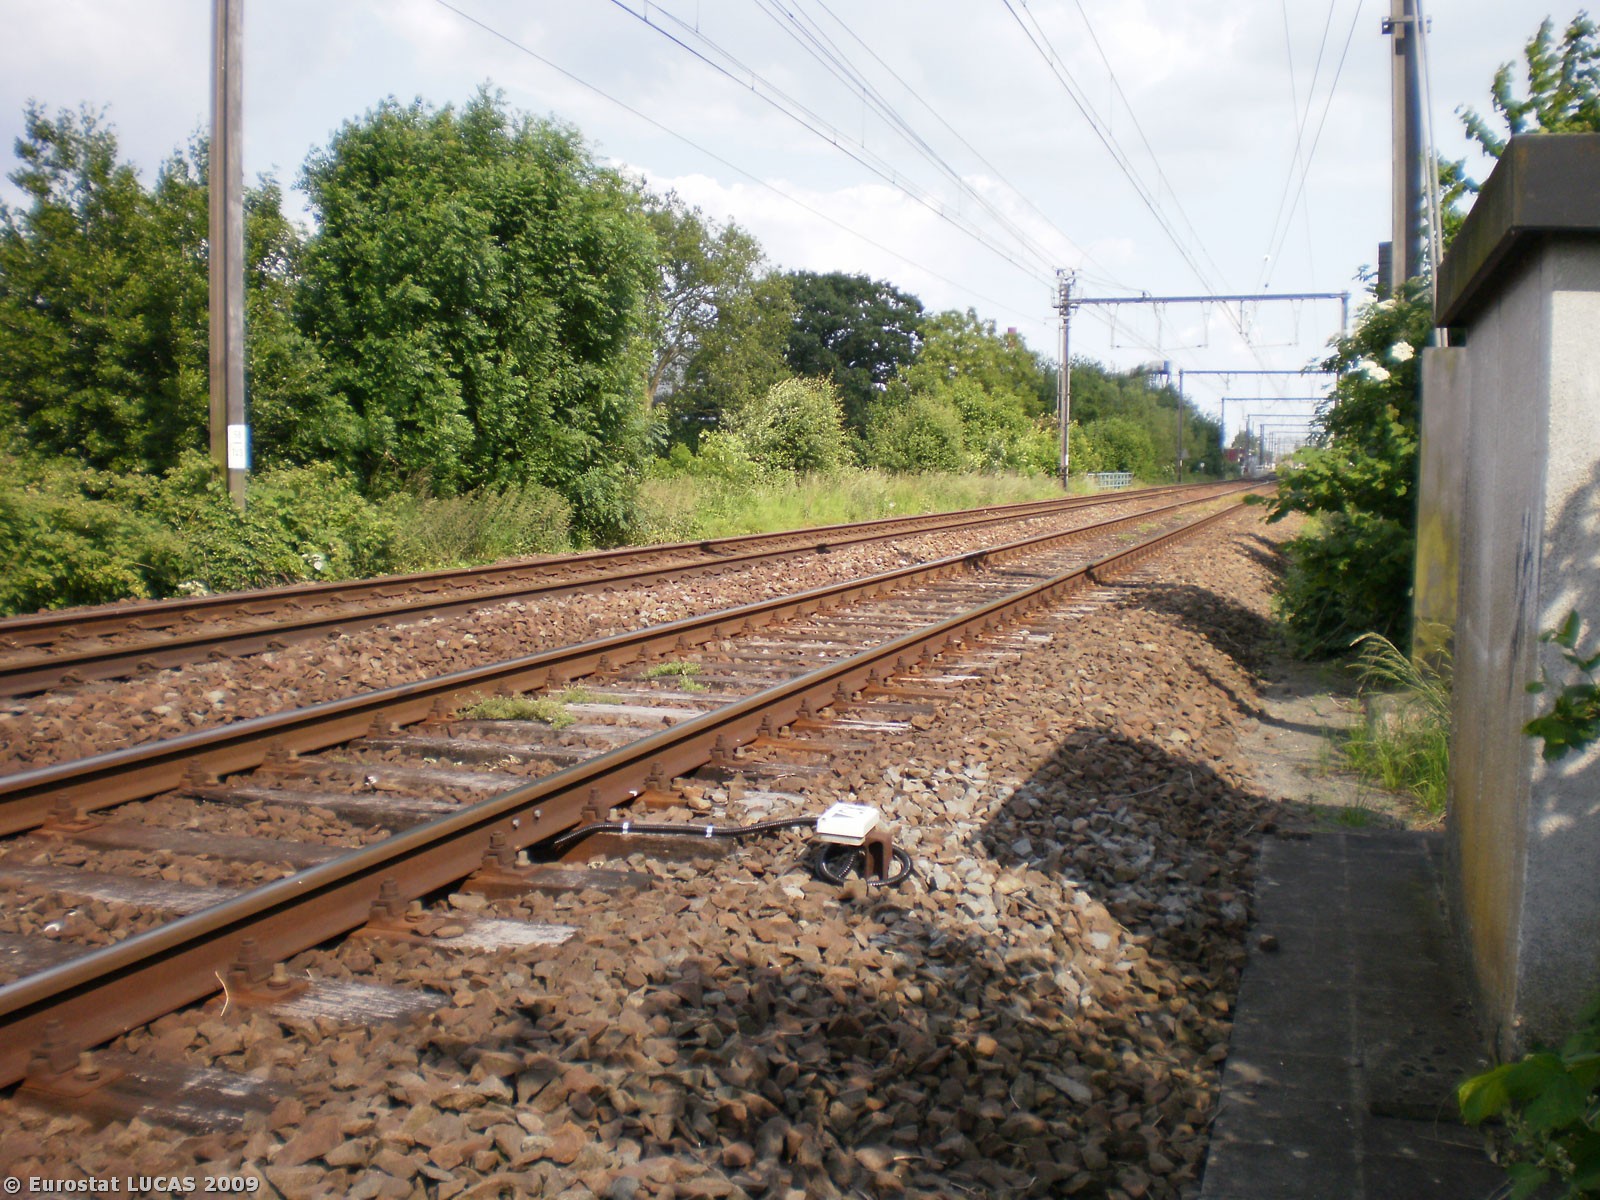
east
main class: Shrubland
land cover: Shrubland without tree cover
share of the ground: > 75 %
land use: Unused
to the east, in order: Shrubland without tree cover; Broadleaved woodland; Railways; Broadleaved woodland; Grassland with sparse tree/shrub cover; Paved roads, cycling and walking lanes; Grassland with sparse tree/shrub cover; Paved roads, cycling and walking lanes; Artificial constructions in urban areas
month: June
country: BE
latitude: 50.5952
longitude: 3.8485
